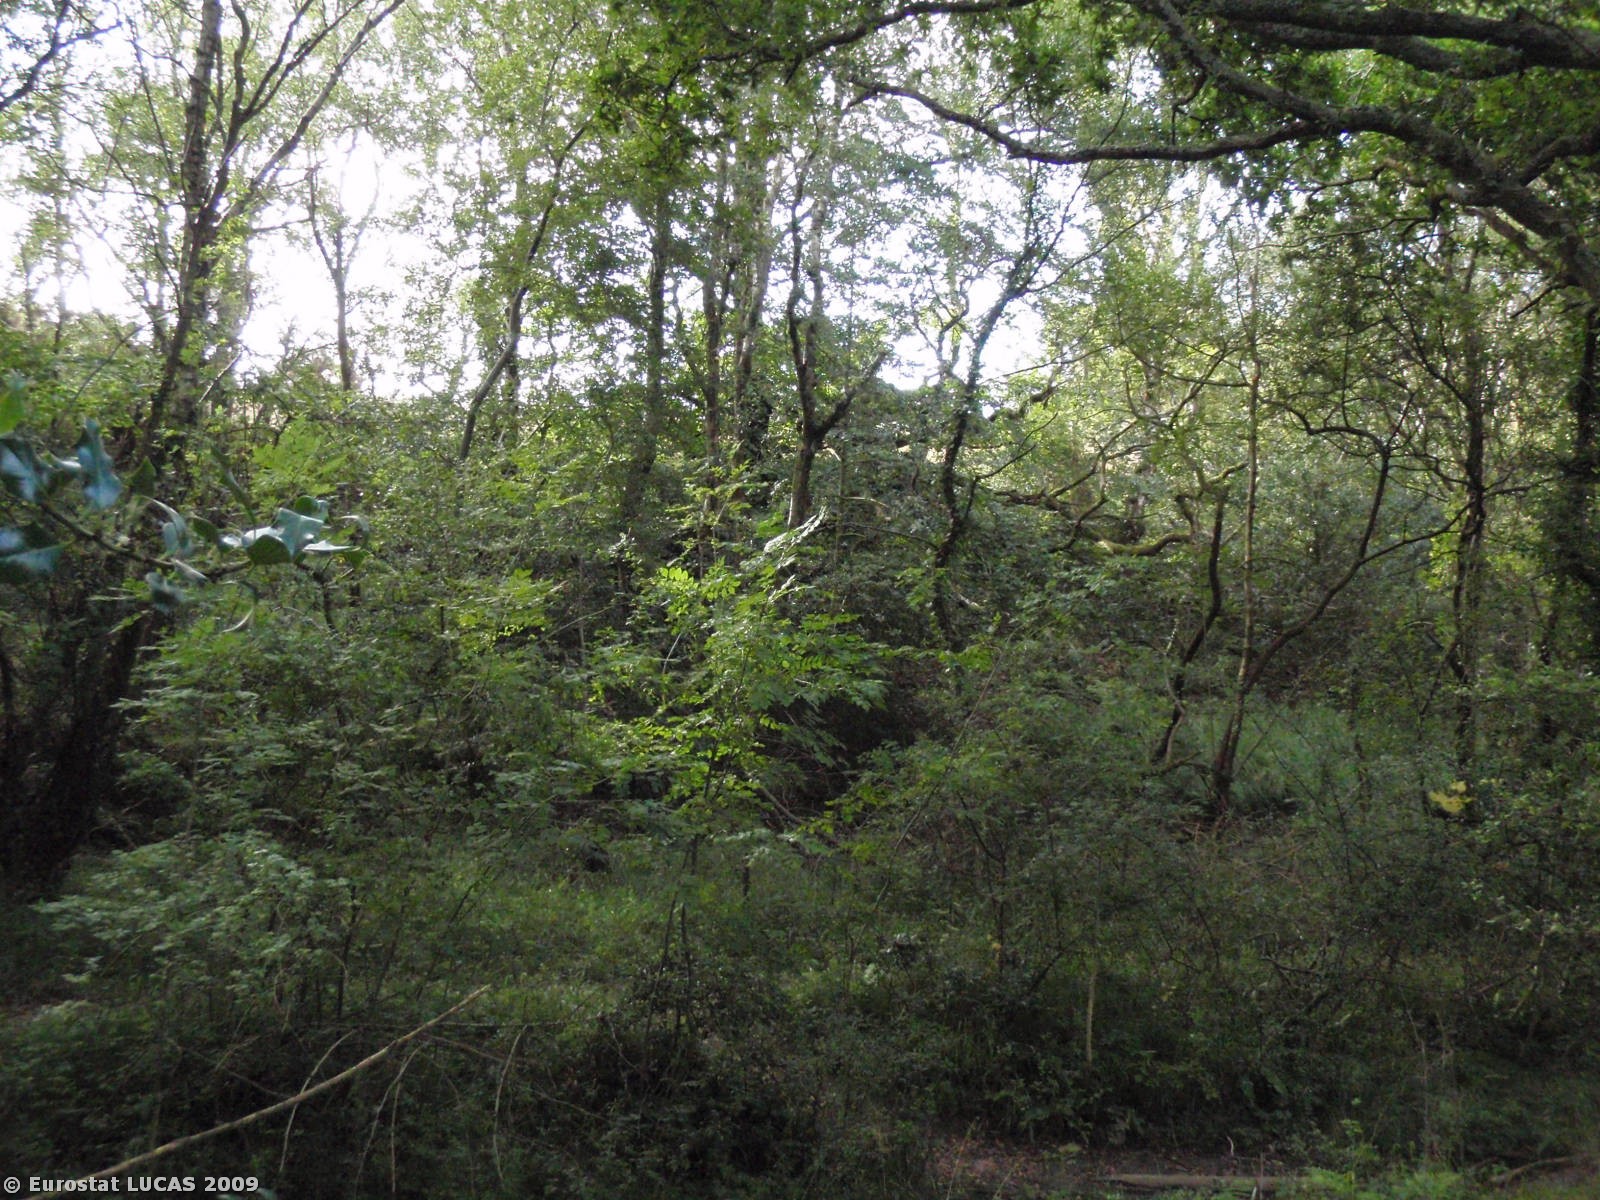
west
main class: Woodland
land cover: Broadleaved woodland
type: acidophilous oak and oak-birch forest
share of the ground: > 75 %
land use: Unused
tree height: > 5 m
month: September
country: GB
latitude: 50.6469
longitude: -2.0947
